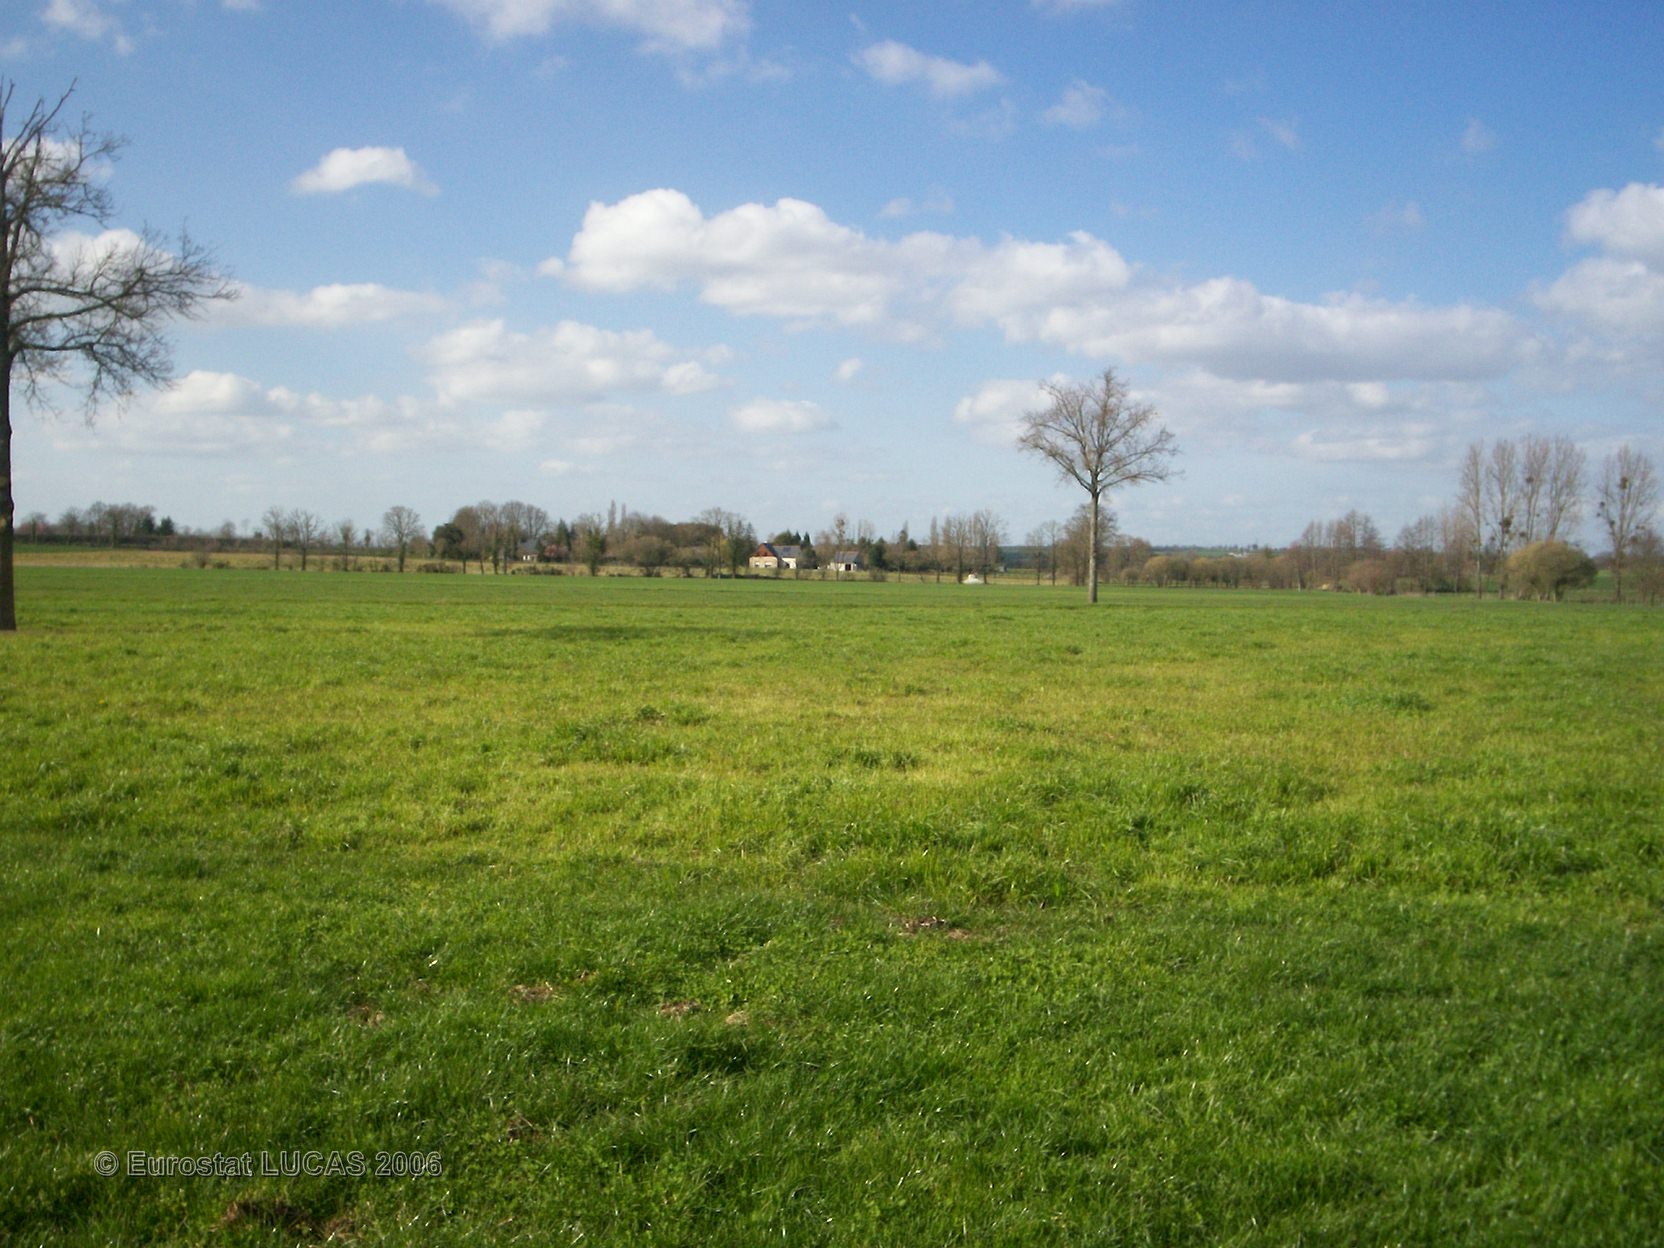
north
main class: Grassland
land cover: Grassland without tree/shrub cover
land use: Agriculture (excluding fallow land and kitchen gardens)
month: April
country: FR
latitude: 47.9846
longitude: -1.3108
